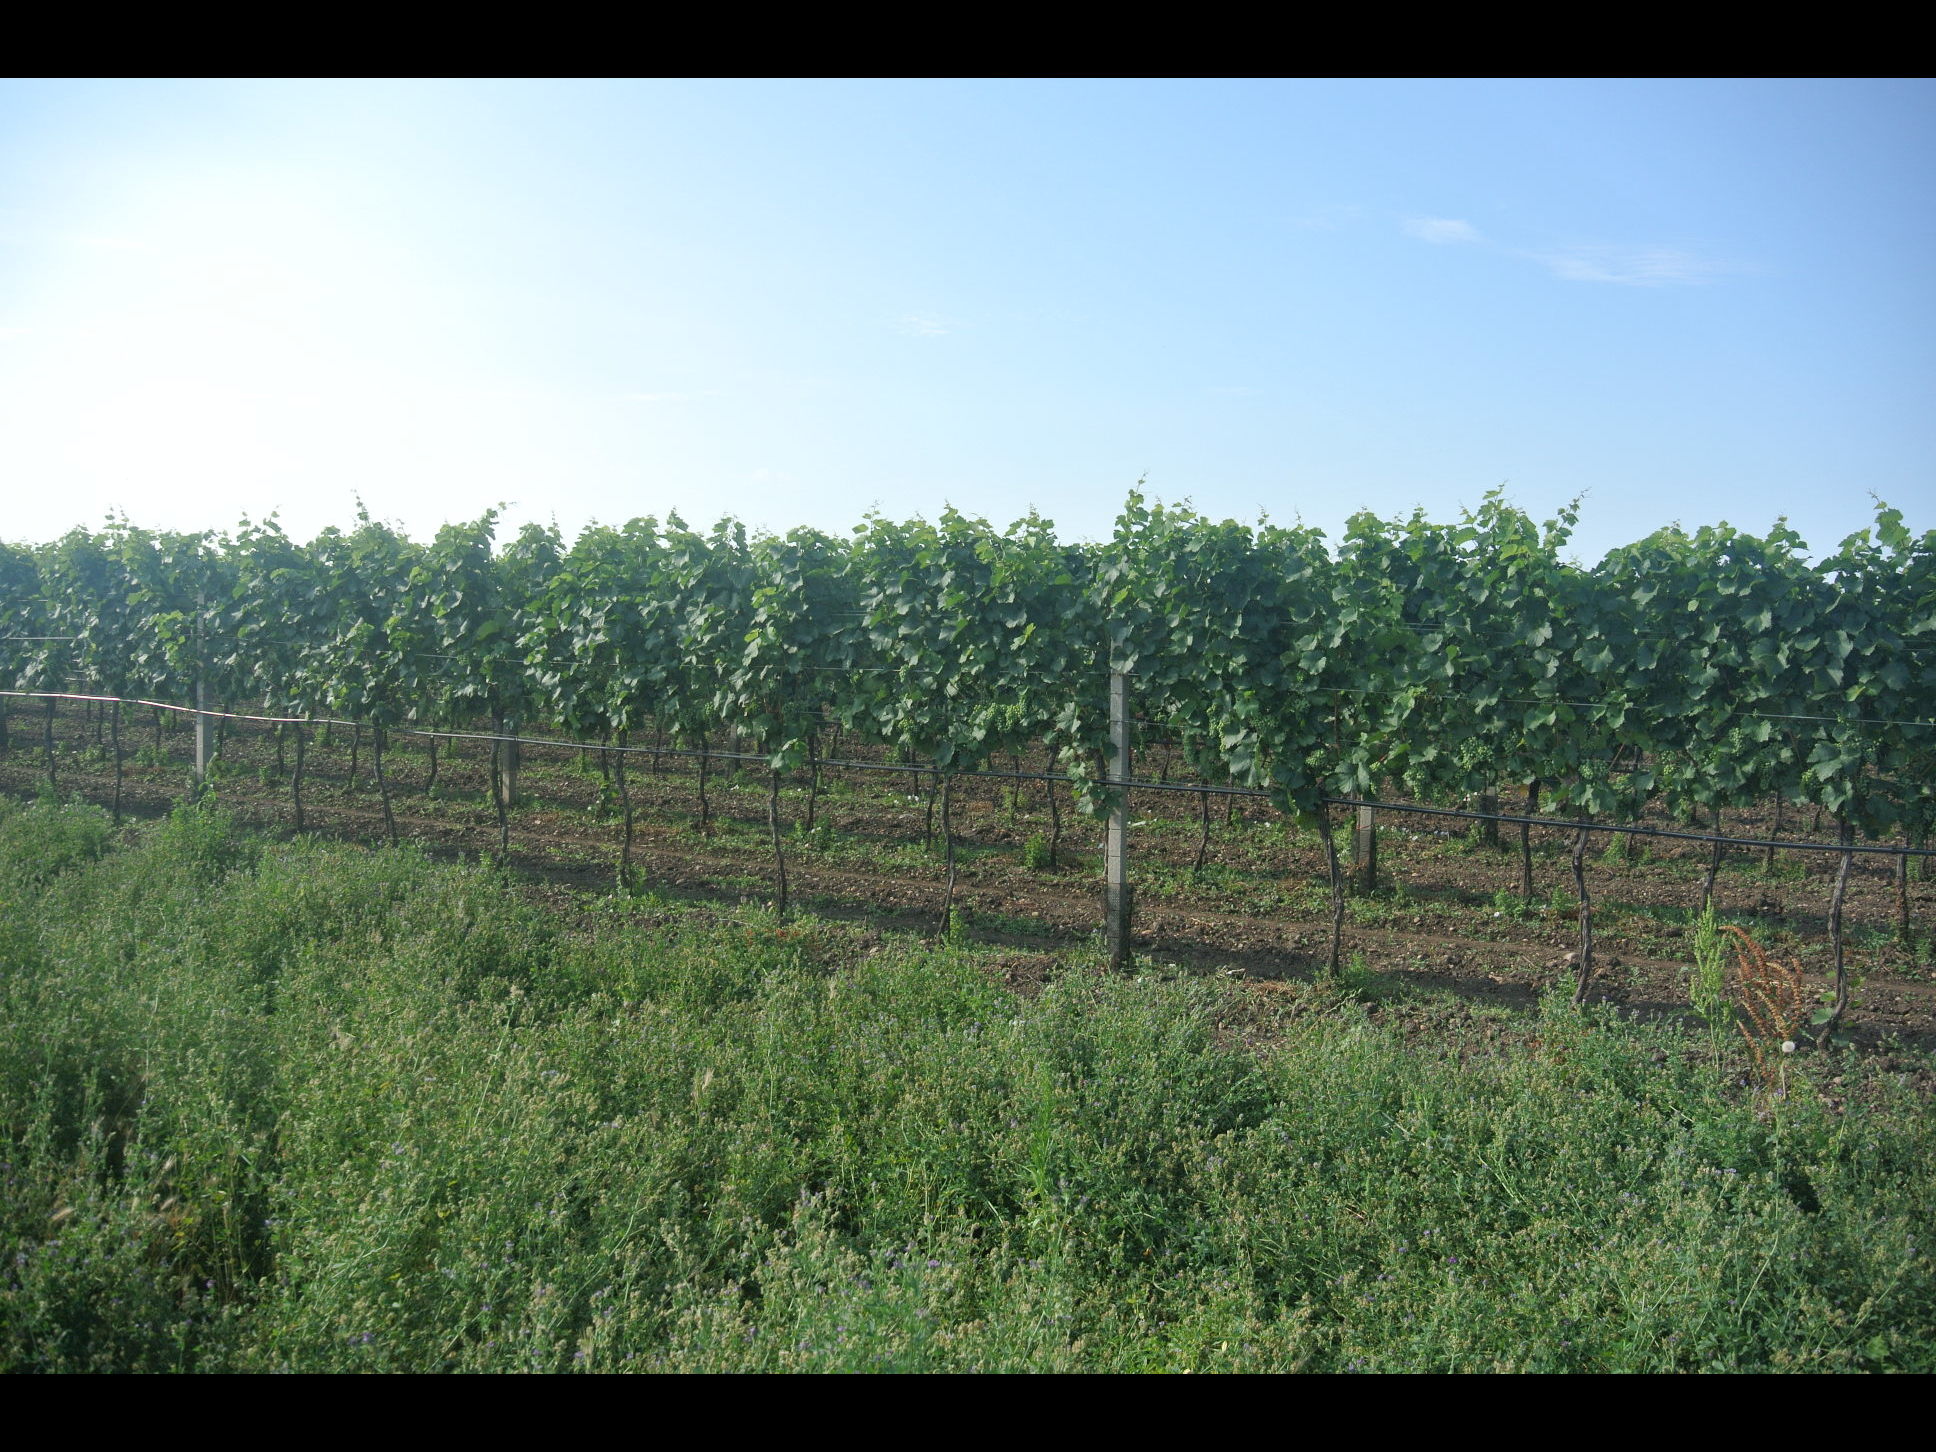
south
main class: Cropland
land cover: Clovers
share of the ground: > 75 %
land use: Agriculture (excluding fallow land and kitchen gardens)
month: July
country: AT
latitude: 47.7772
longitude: 16.8253
